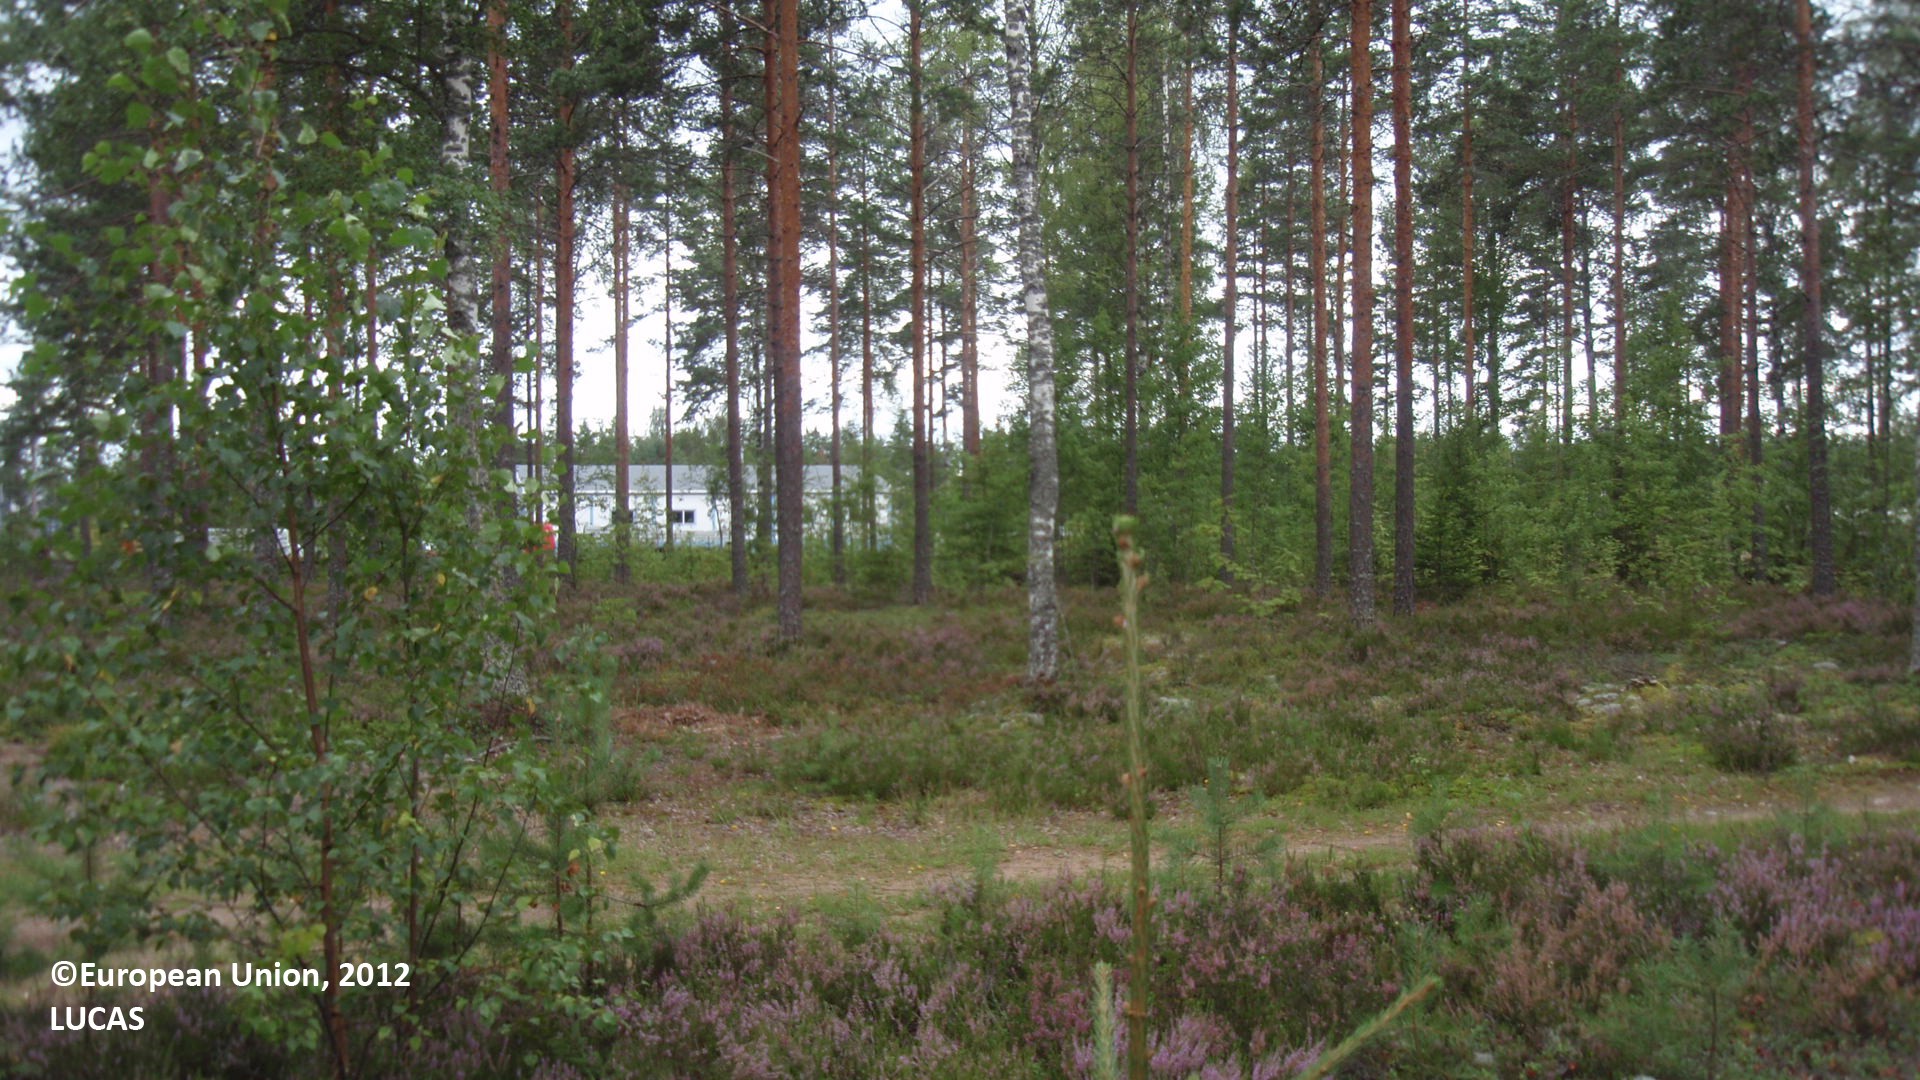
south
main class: Woodland
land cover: Pine dominated mixed woodland
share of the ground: 25 - 50 %
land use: Community services
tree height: > 5 m
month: August
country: FI
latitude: 60.9199
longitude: 27.5405
